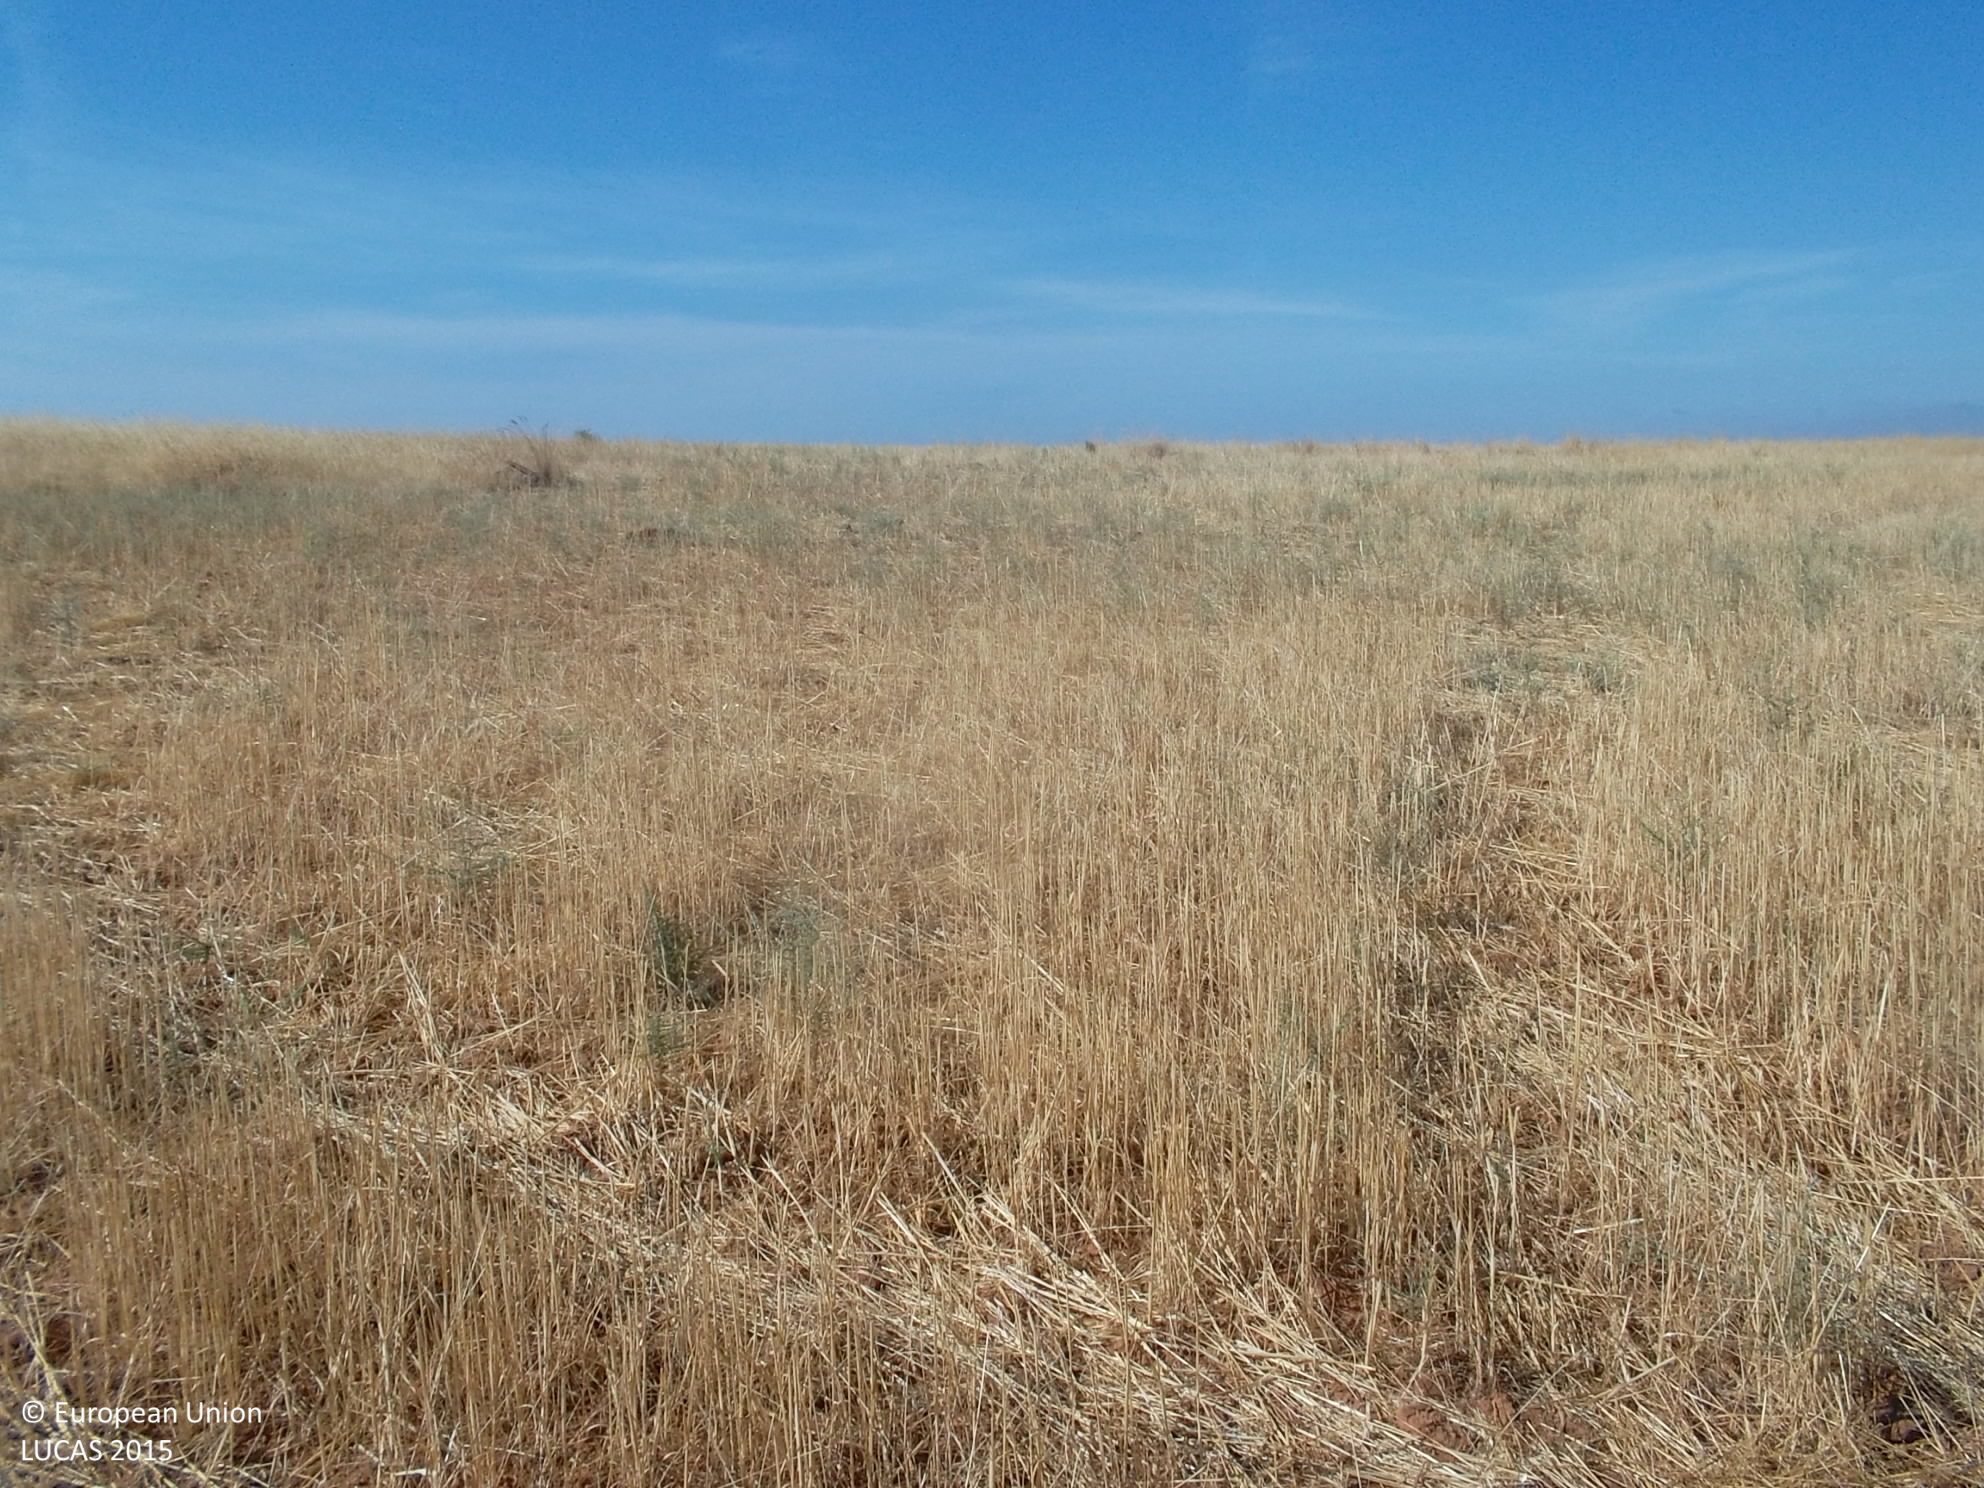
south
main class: Cropland
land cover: Oats
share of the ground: > 75 %
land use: Agriculture (excluding fallow land and kitchen gardens)
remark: Harvested field
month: September
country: ES
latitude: 38.2796
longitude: -6.3362
